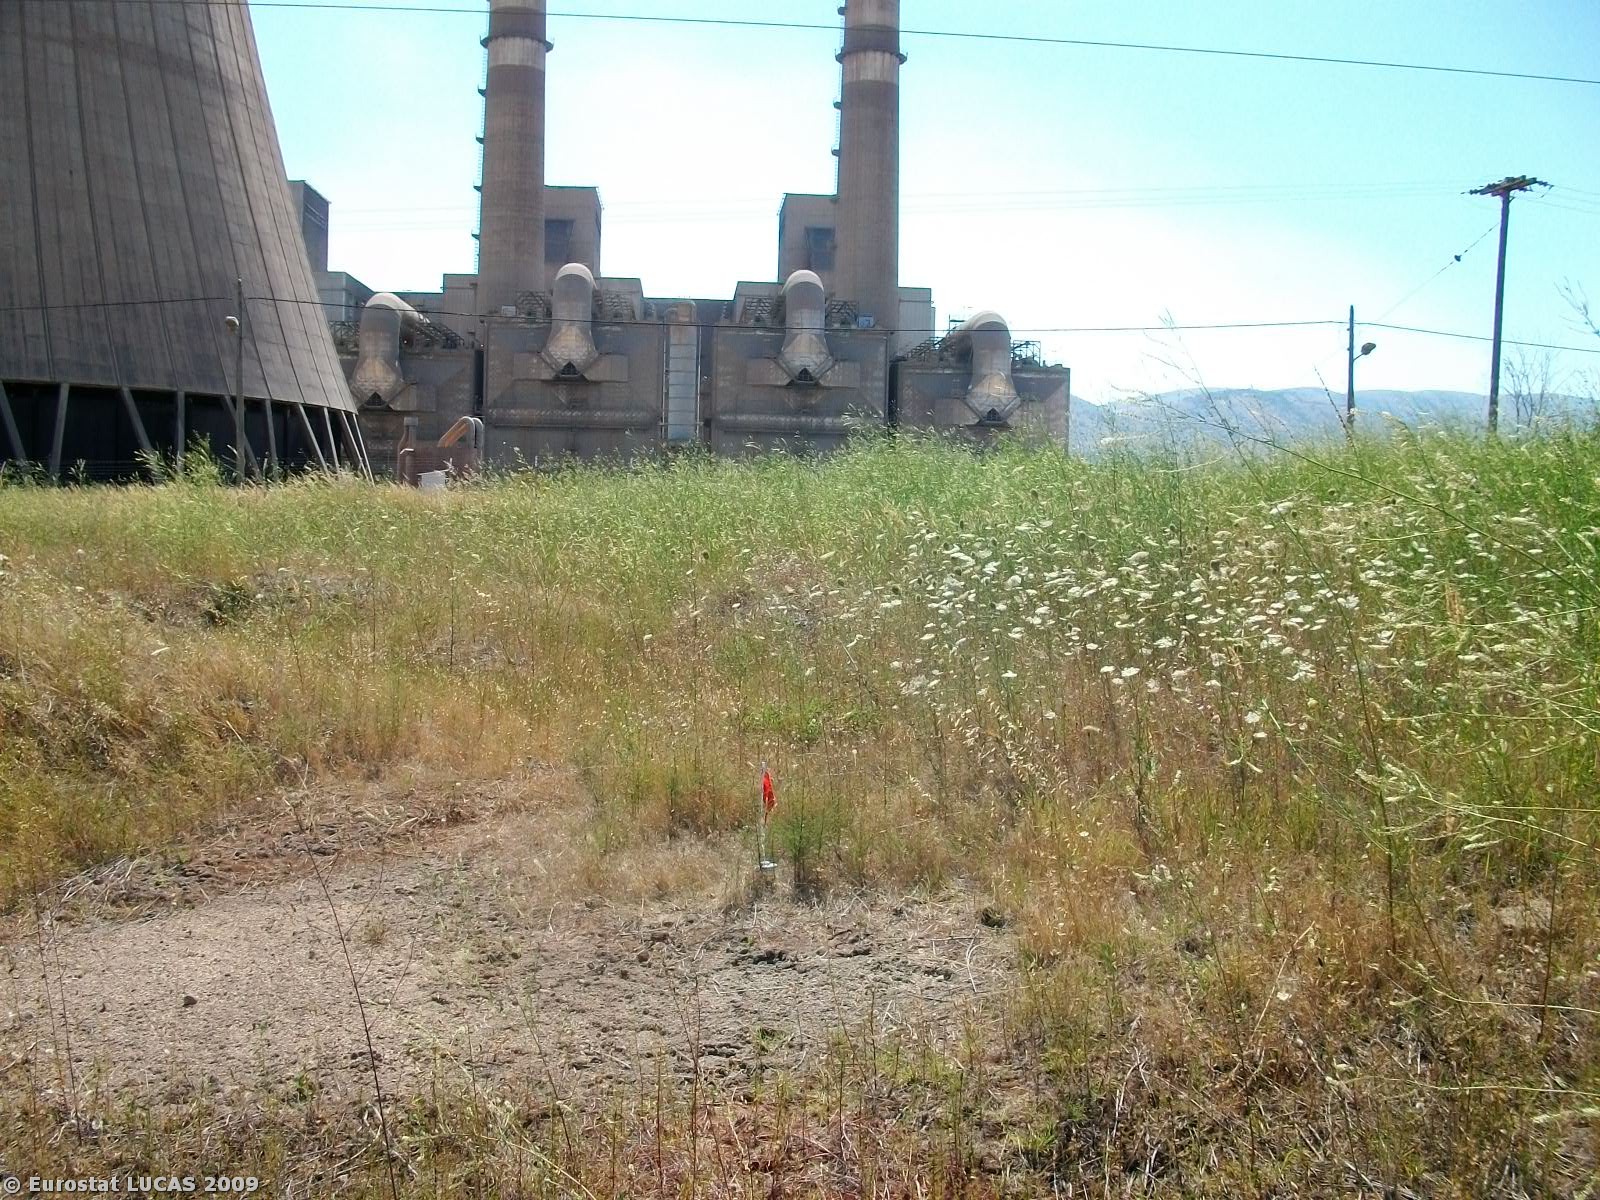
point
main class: Grassland
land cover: Grassland without tree/shrub cover
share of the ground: 50 - 75 %
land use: Unused
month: July
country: GR
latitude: 40.4122
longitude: 21.7893
